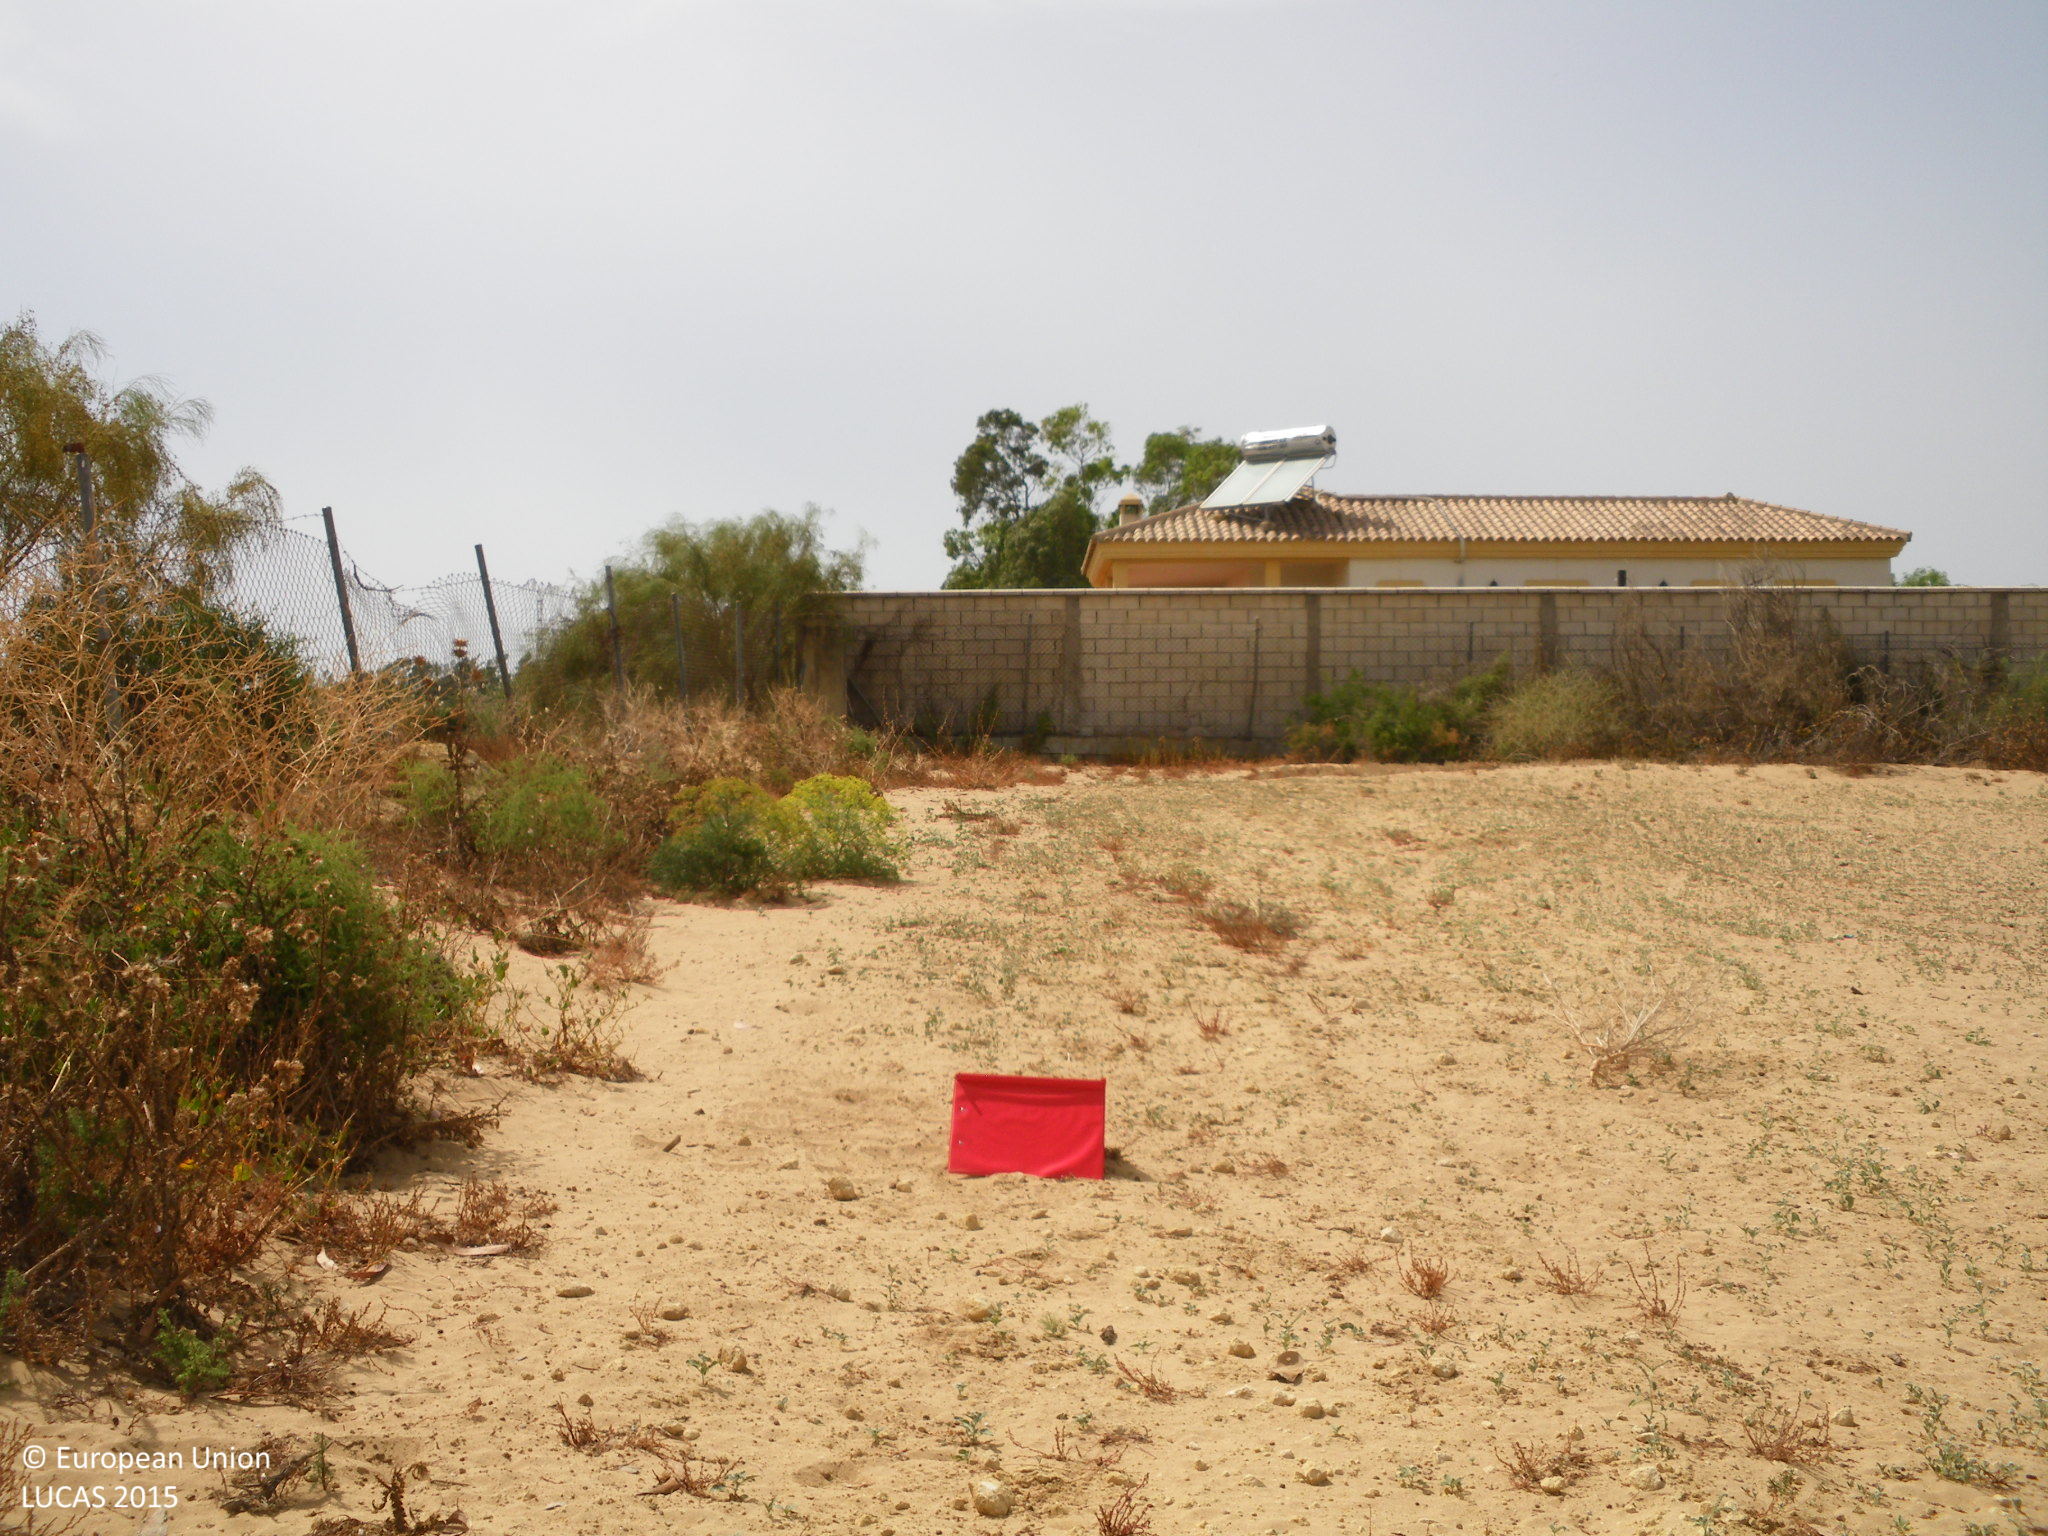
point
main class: Grassland
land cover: Grassland without tree/shrub cover
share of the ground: 10 - 25 %
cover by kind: unconsolidated bare surface 85 %, herbaceous plants 15 %
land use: Semi-natural and natural areas not in use
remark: Clear cut
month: June
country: ES
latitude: 36.6150
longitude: -6.2586
